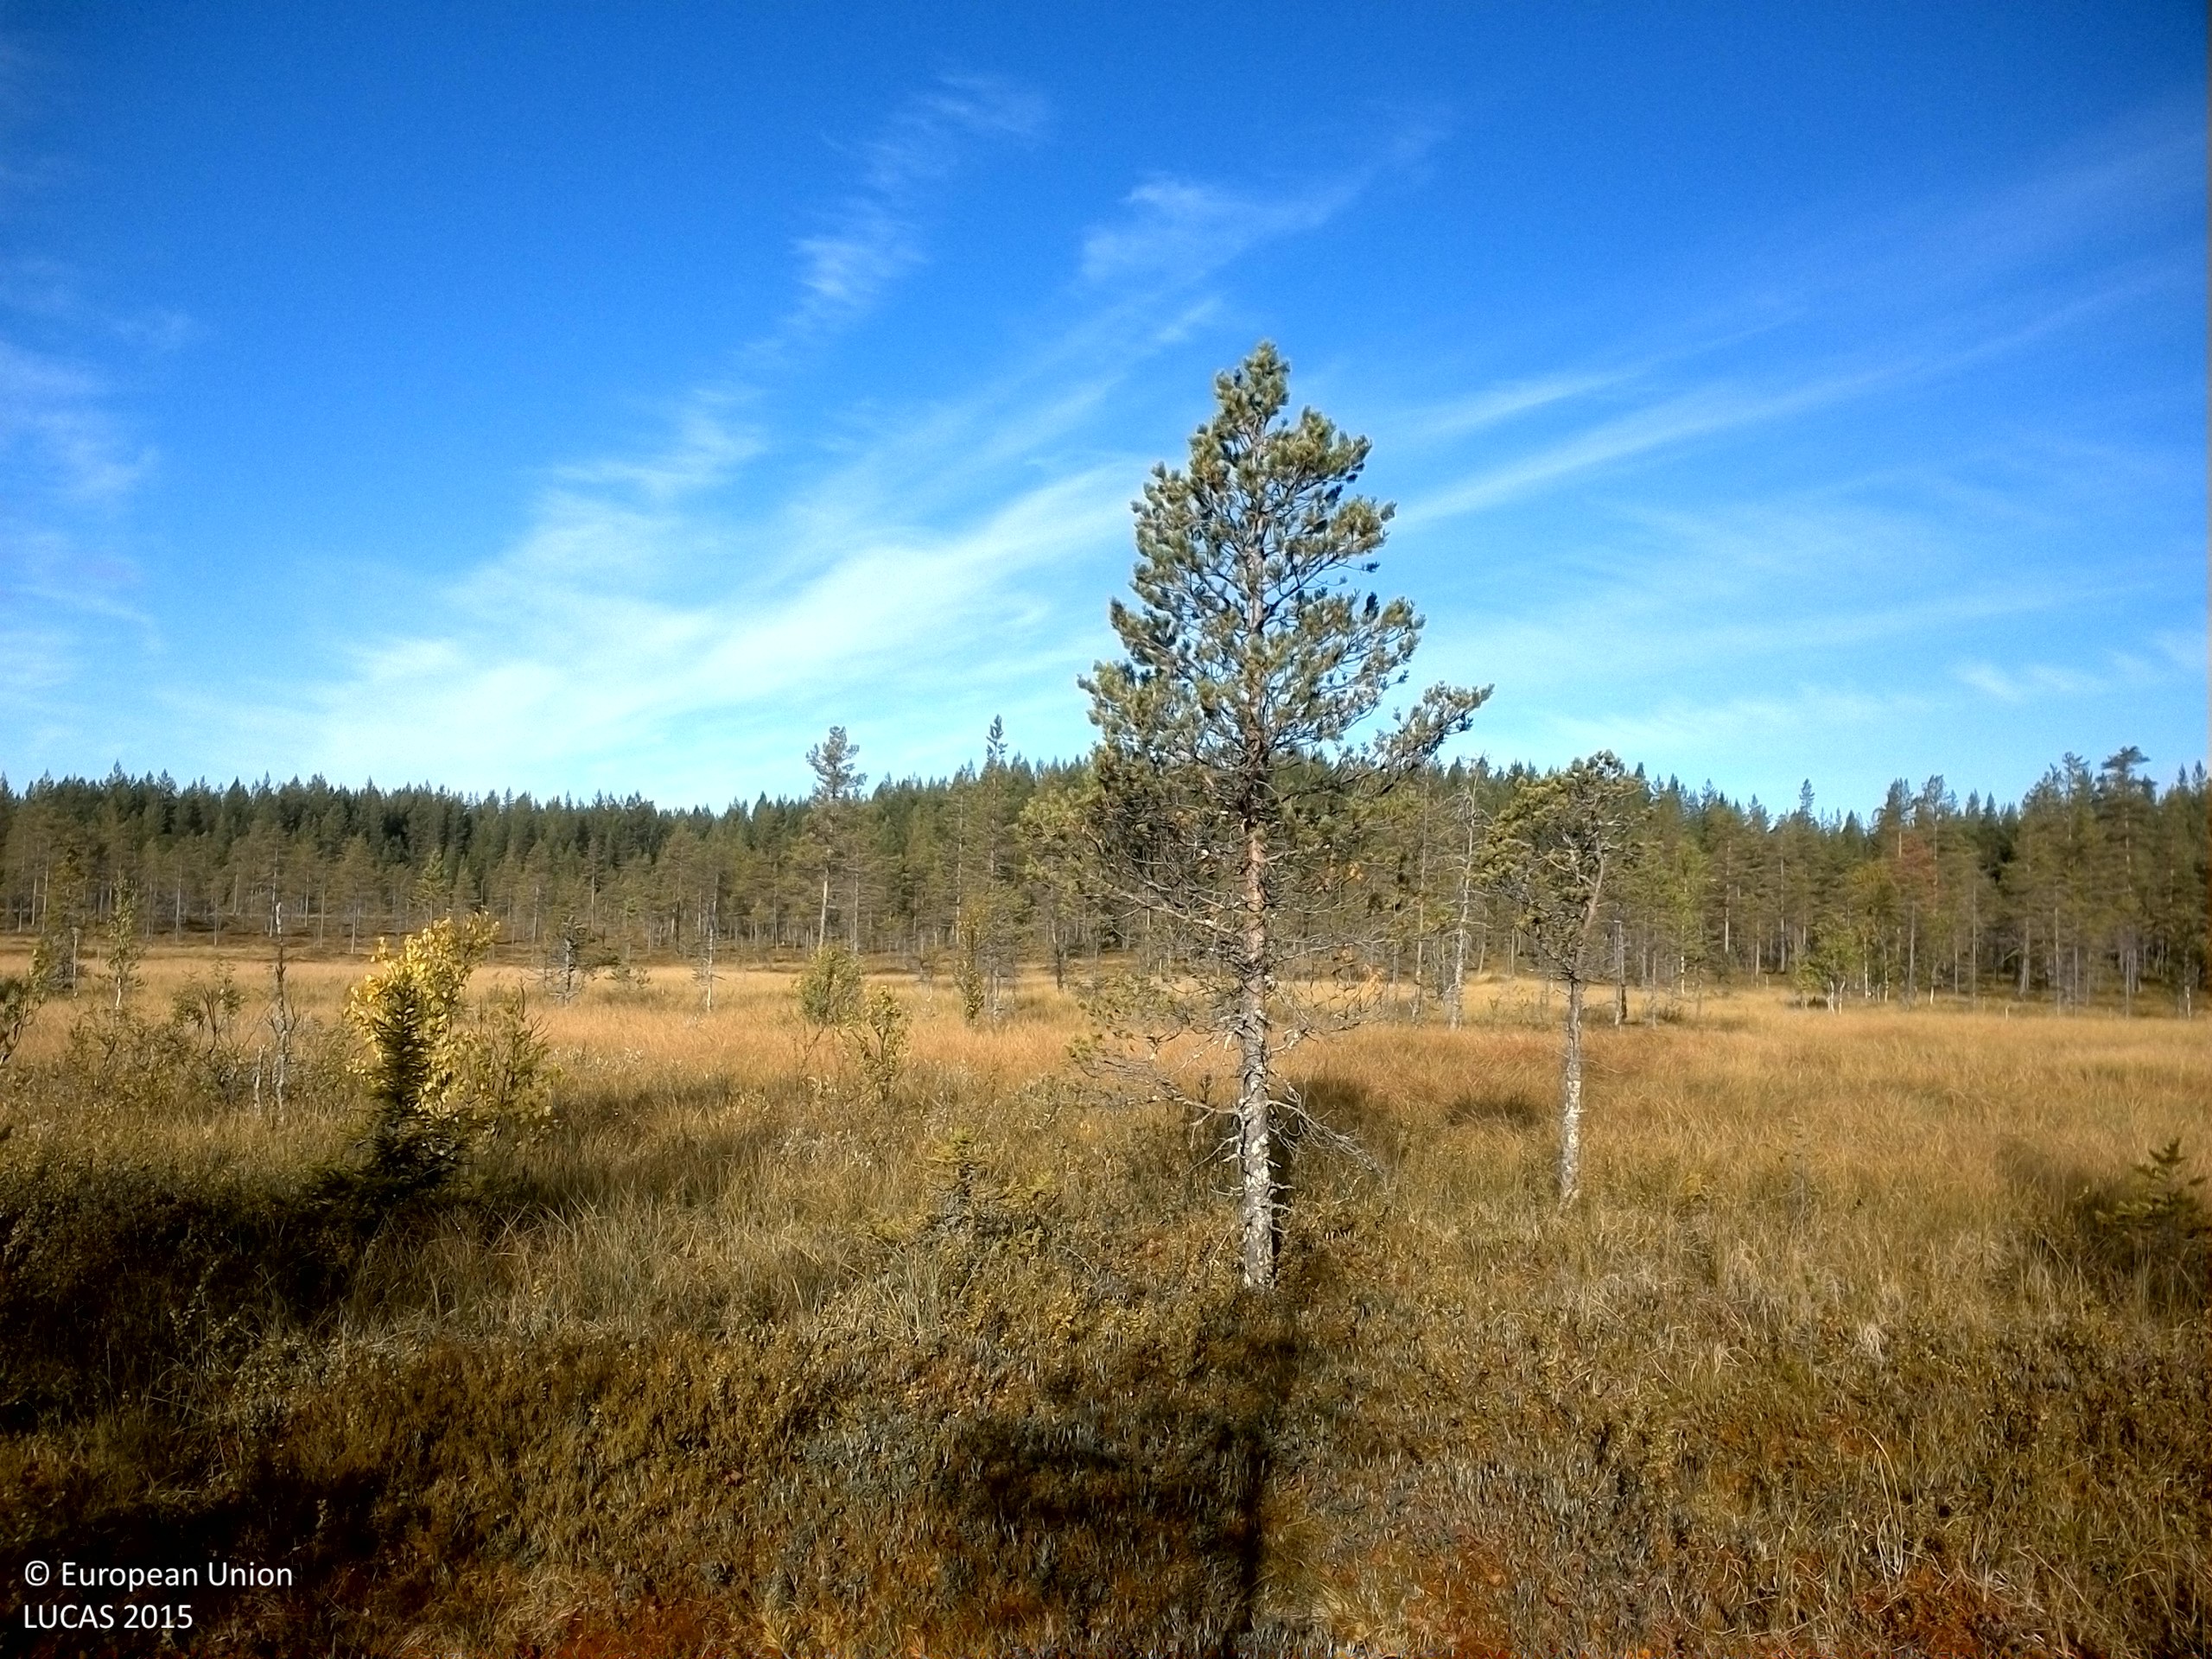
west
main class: Woodland
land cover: Pine dominated coniferous woodland
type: boreal forest
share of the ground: 10 - 25 %
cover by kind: lichens and mosses 50 %, shrubs 35 %, coniferous forest trees 15 %
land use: Semi-natural and natural areas not in use
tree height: < 5 m
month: September
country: SE
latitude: 63.9785
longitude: 17.6322
